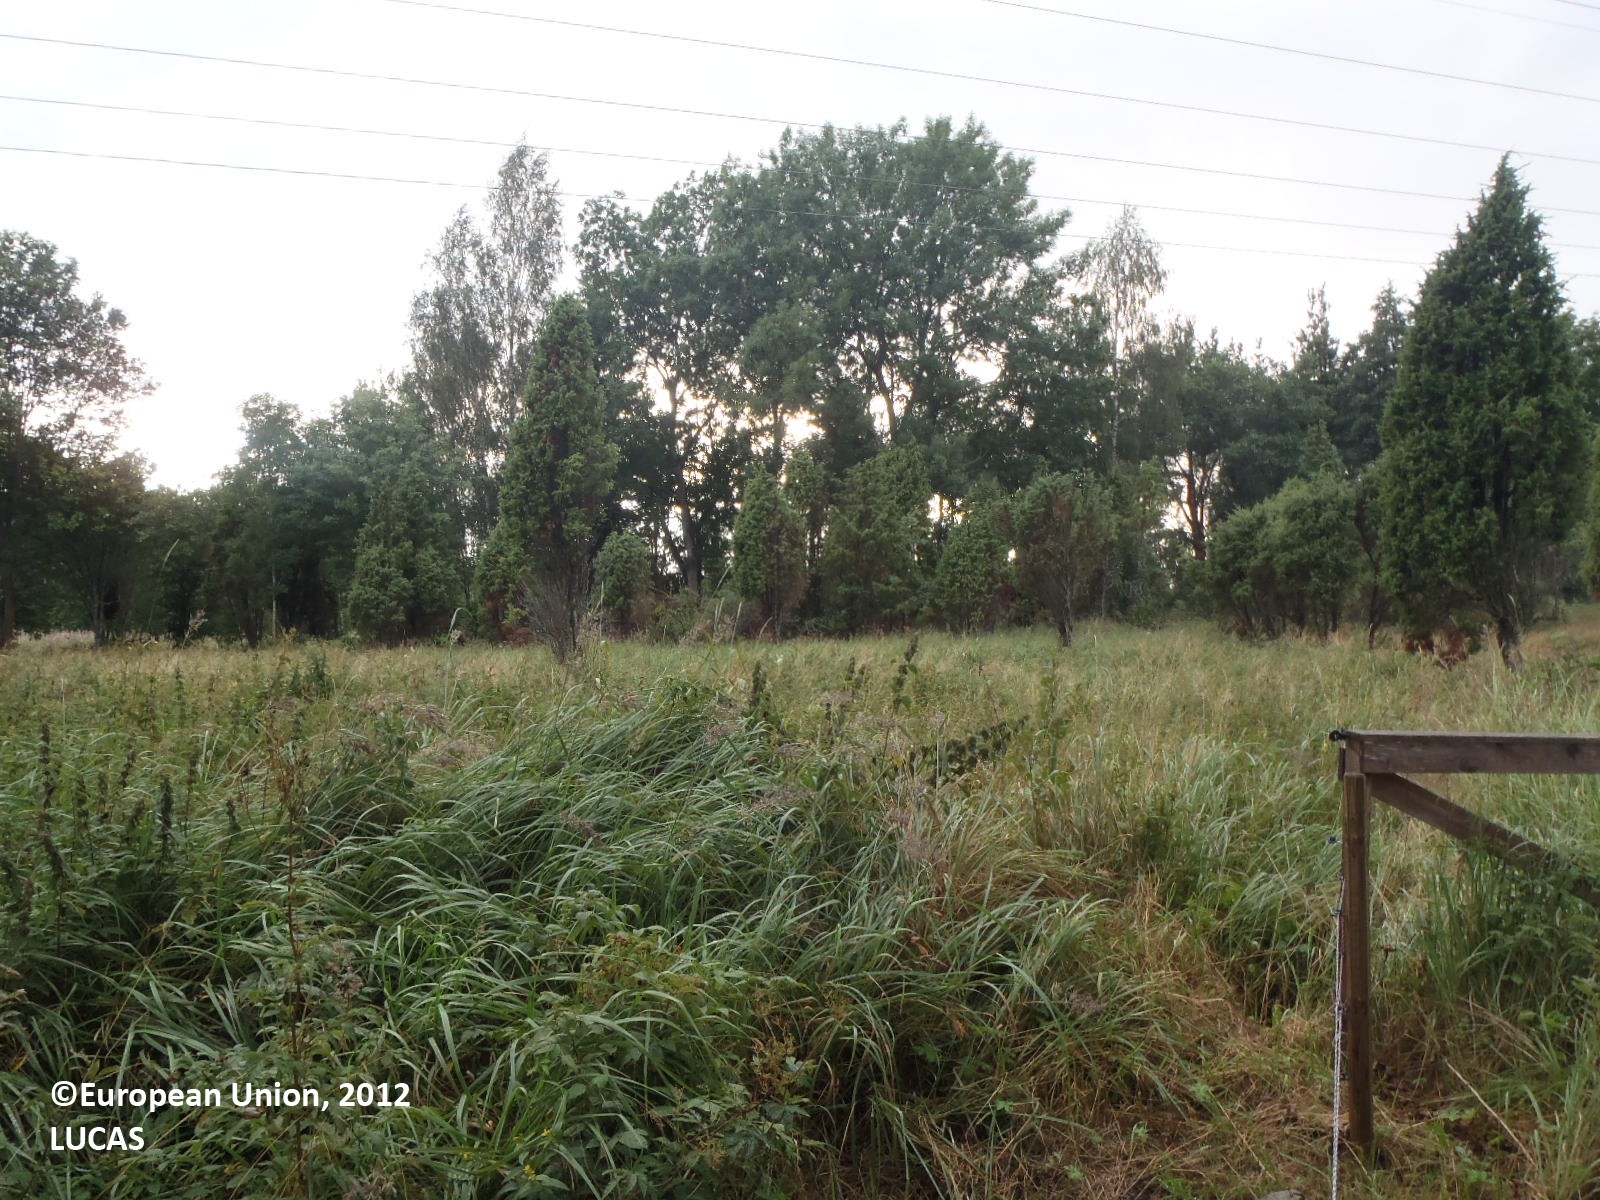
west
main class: Woodland
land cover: Broadleaved woodland
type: hemiboreal forest and nemoral coniferous forest and mixed broadleaved-coniferous forest
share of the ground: > 75 %
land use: Agriculture (excluding fallow land and kitchen gardens)
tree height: > 5 m
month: August
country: FI
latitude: 60.1208
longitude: 19.9223
